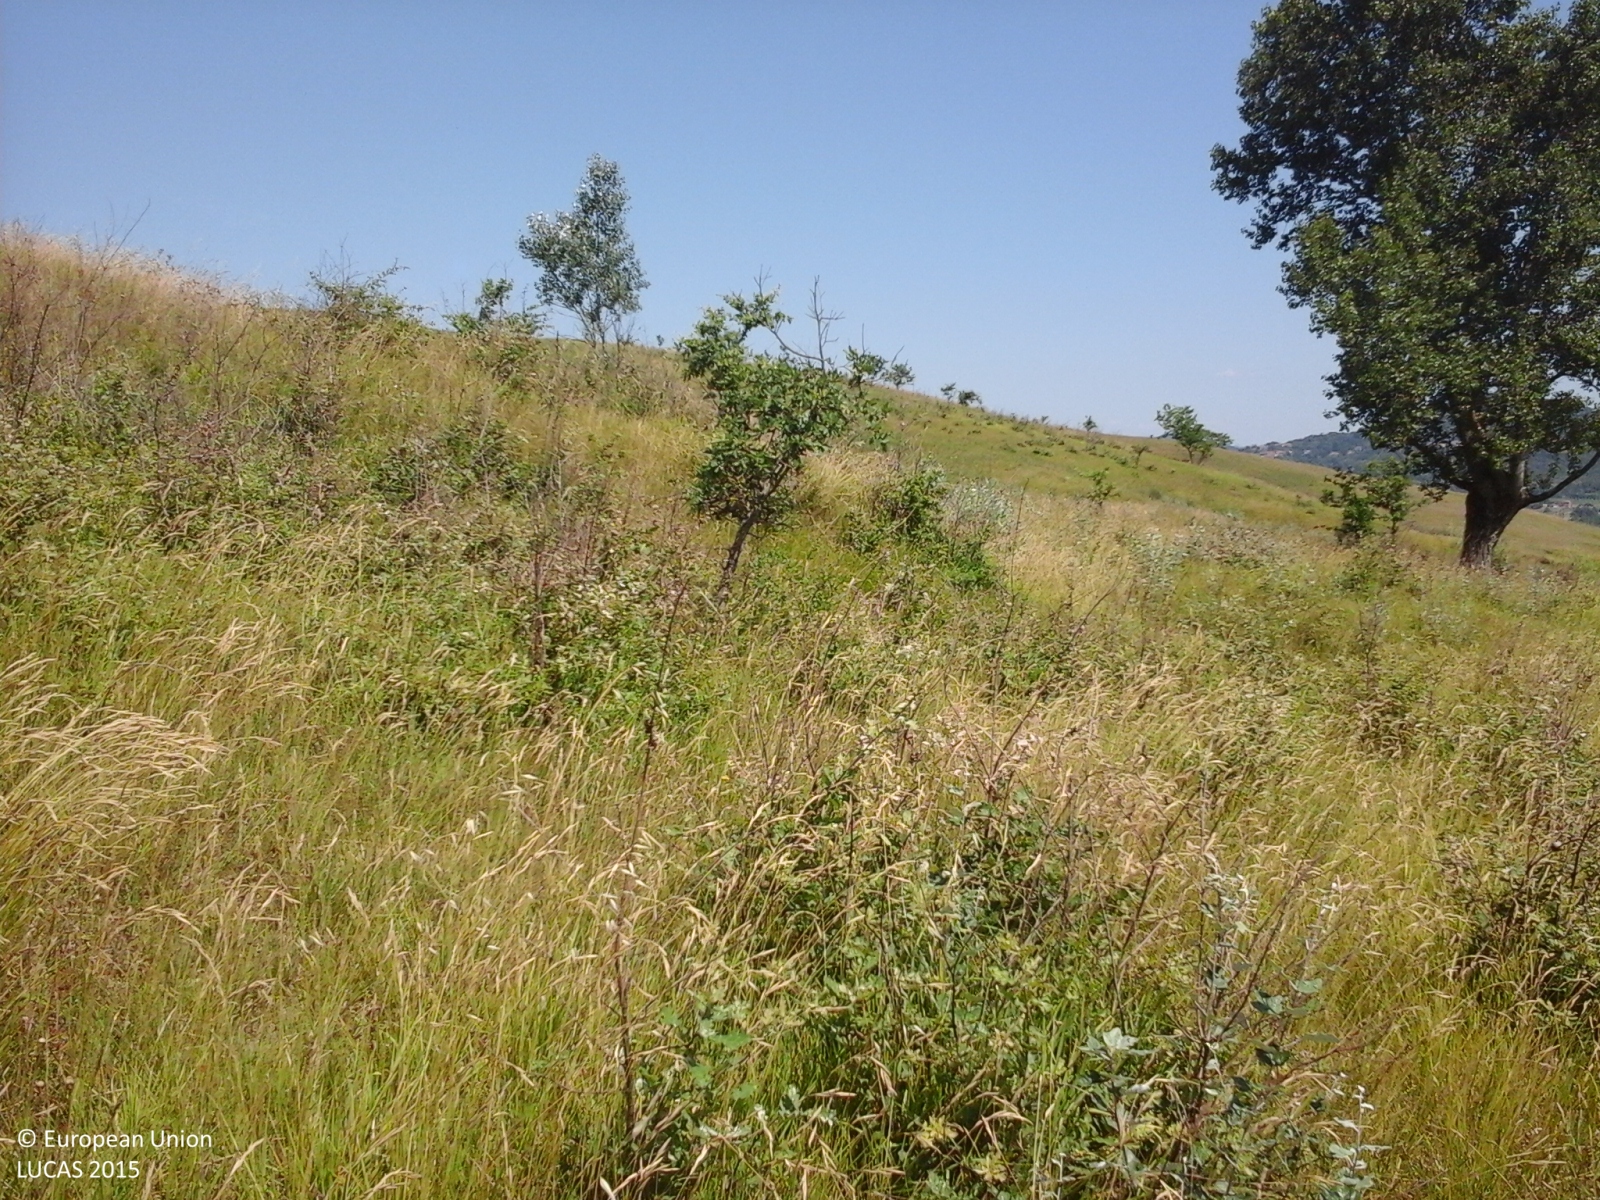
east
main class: Shrubland
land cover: Shrubland with sparse tree cover
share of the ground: > 75 %
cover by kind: herbaceous plants 60 %, shrubs 35 %, broadleaved forest trees 5 %
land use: Abandoned areas
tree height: > 5 m
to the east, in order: Shrubland with sparse tree cover; Grassland without tree/shrub cover; Ditches and canals; Grassland without tree/shrub cover
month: July
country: IT
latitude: 41.0616
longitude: 14.6822
